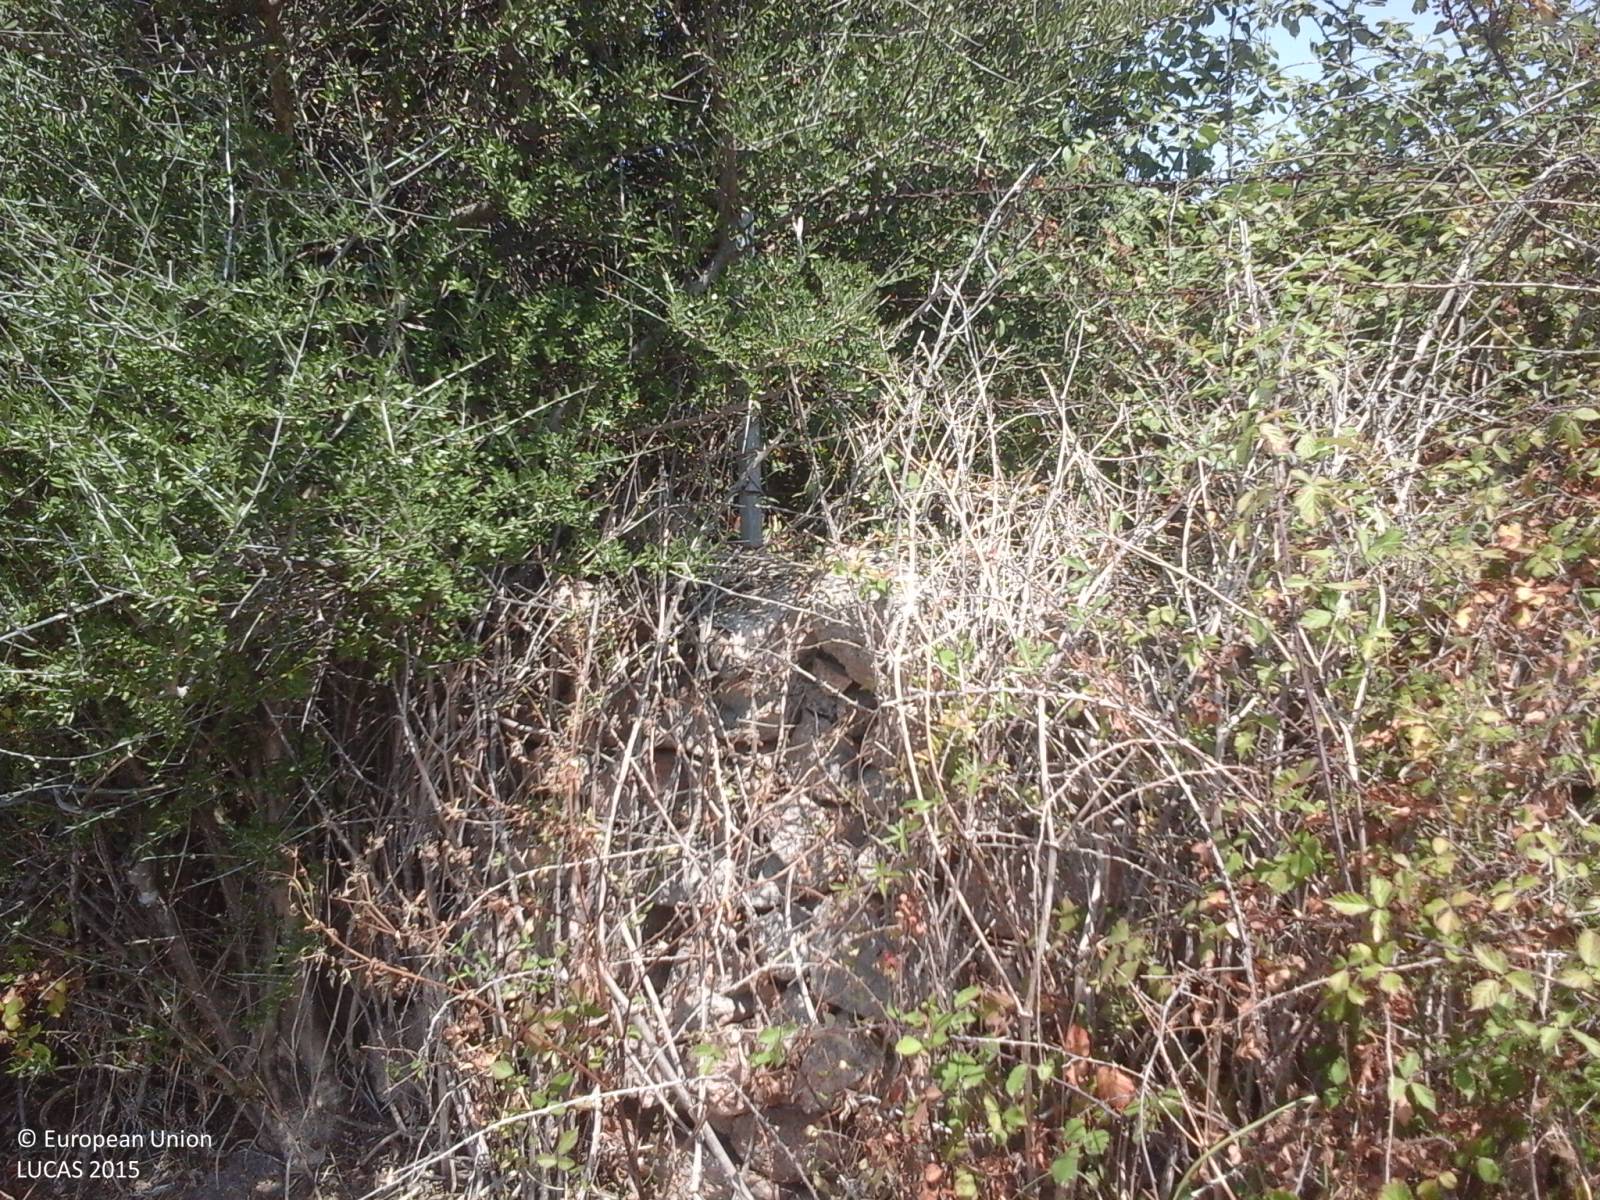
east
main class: Grassland
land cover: Grassland without tree/shrub cover
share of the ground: > 75 %
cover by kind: herbaceous plants 95 %, shrubs 5 %
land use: Agriculture (excluding fallow land and kitchen gardens)
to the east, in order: Grassland without tree/shrub cover; Dry stone walls; Abandoned hedges; Electric lines; Grassland without tree/shrub cover; Shrubland without tree cover; Grassland without tree/shrub cover; Dry stone walls; Fences; Grassland with sparse tree/shrub cover; Grassland without tree/shrub cover; Grassland with sparse tree/shrub cover; Grassland without tree/shrub cover
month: July
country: IT
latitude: 40.8449
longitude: 9.4452
